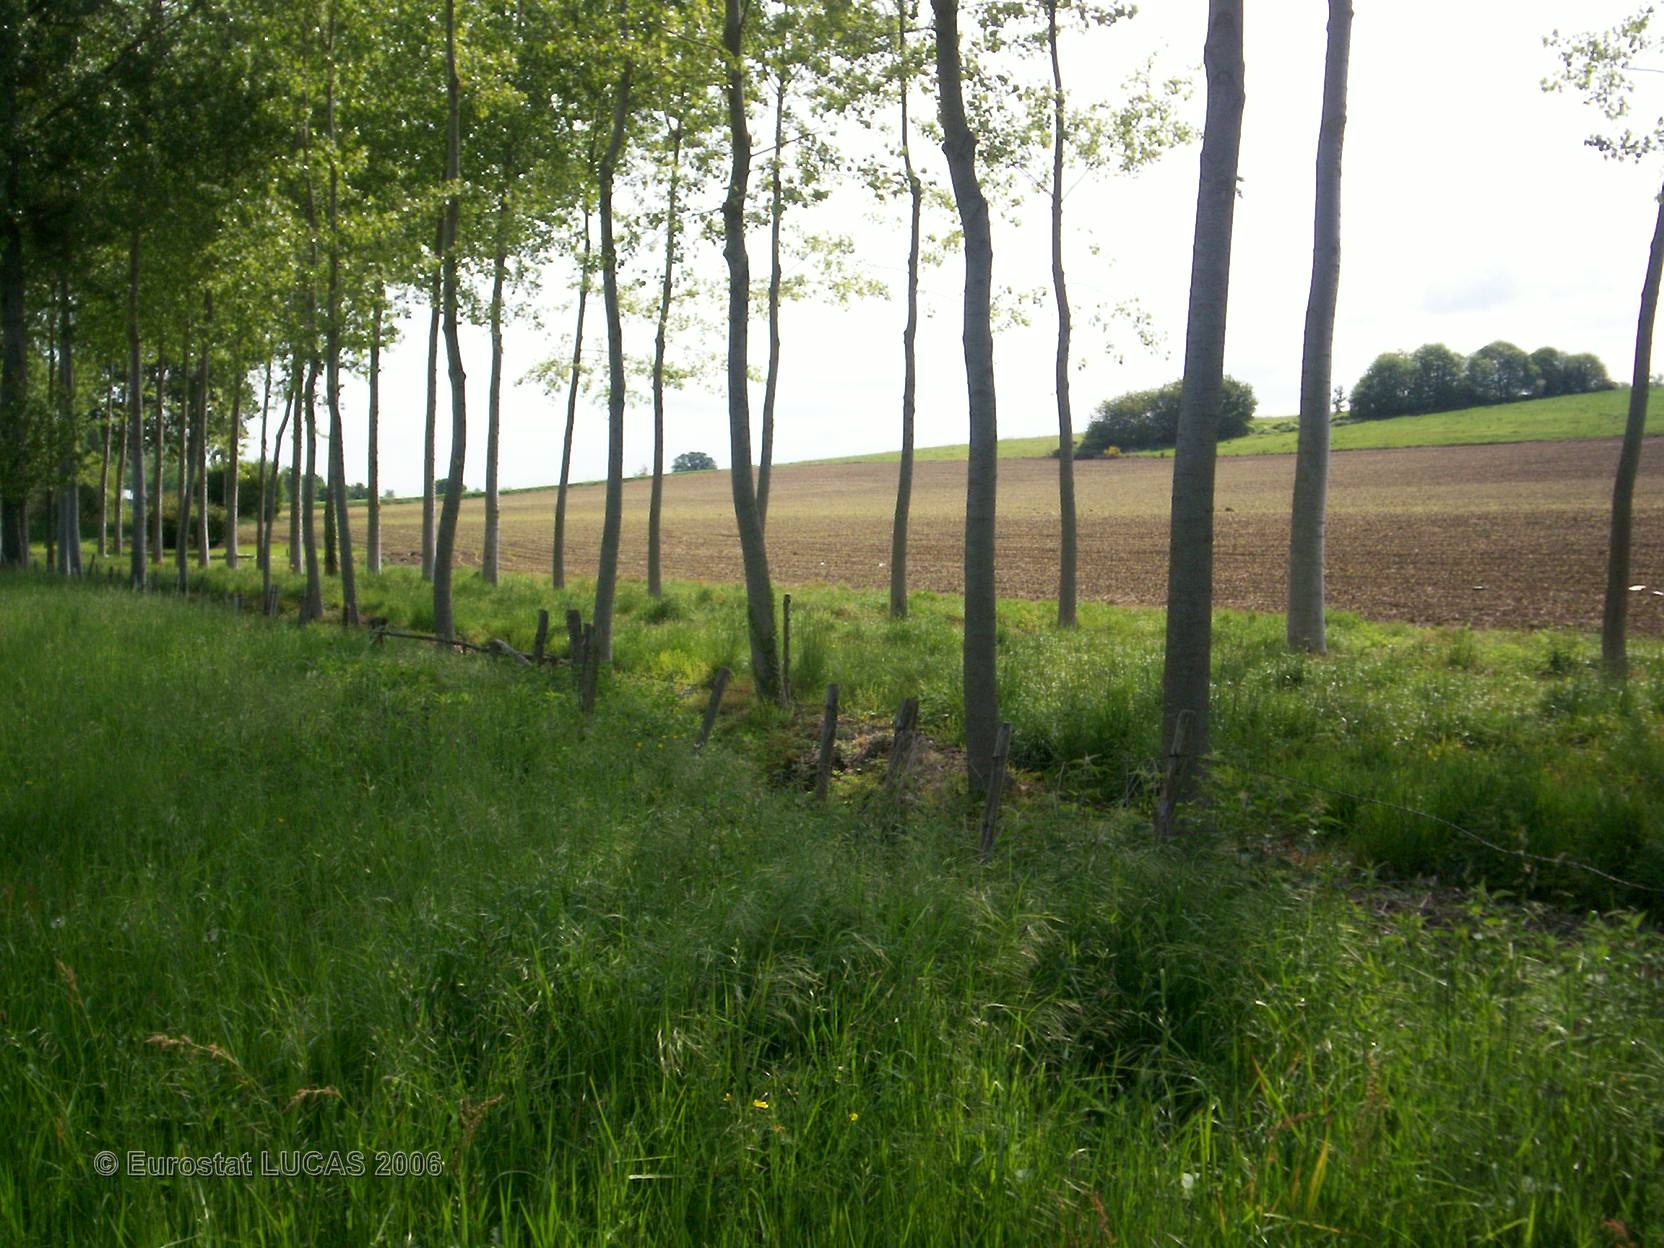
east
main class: Grassland
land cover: Grassland without tree/shrub cover
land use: Agriculture (excluding fallow land and kitchen gardens)
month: May
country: FR
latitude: 47.8184
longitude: 0.1577
